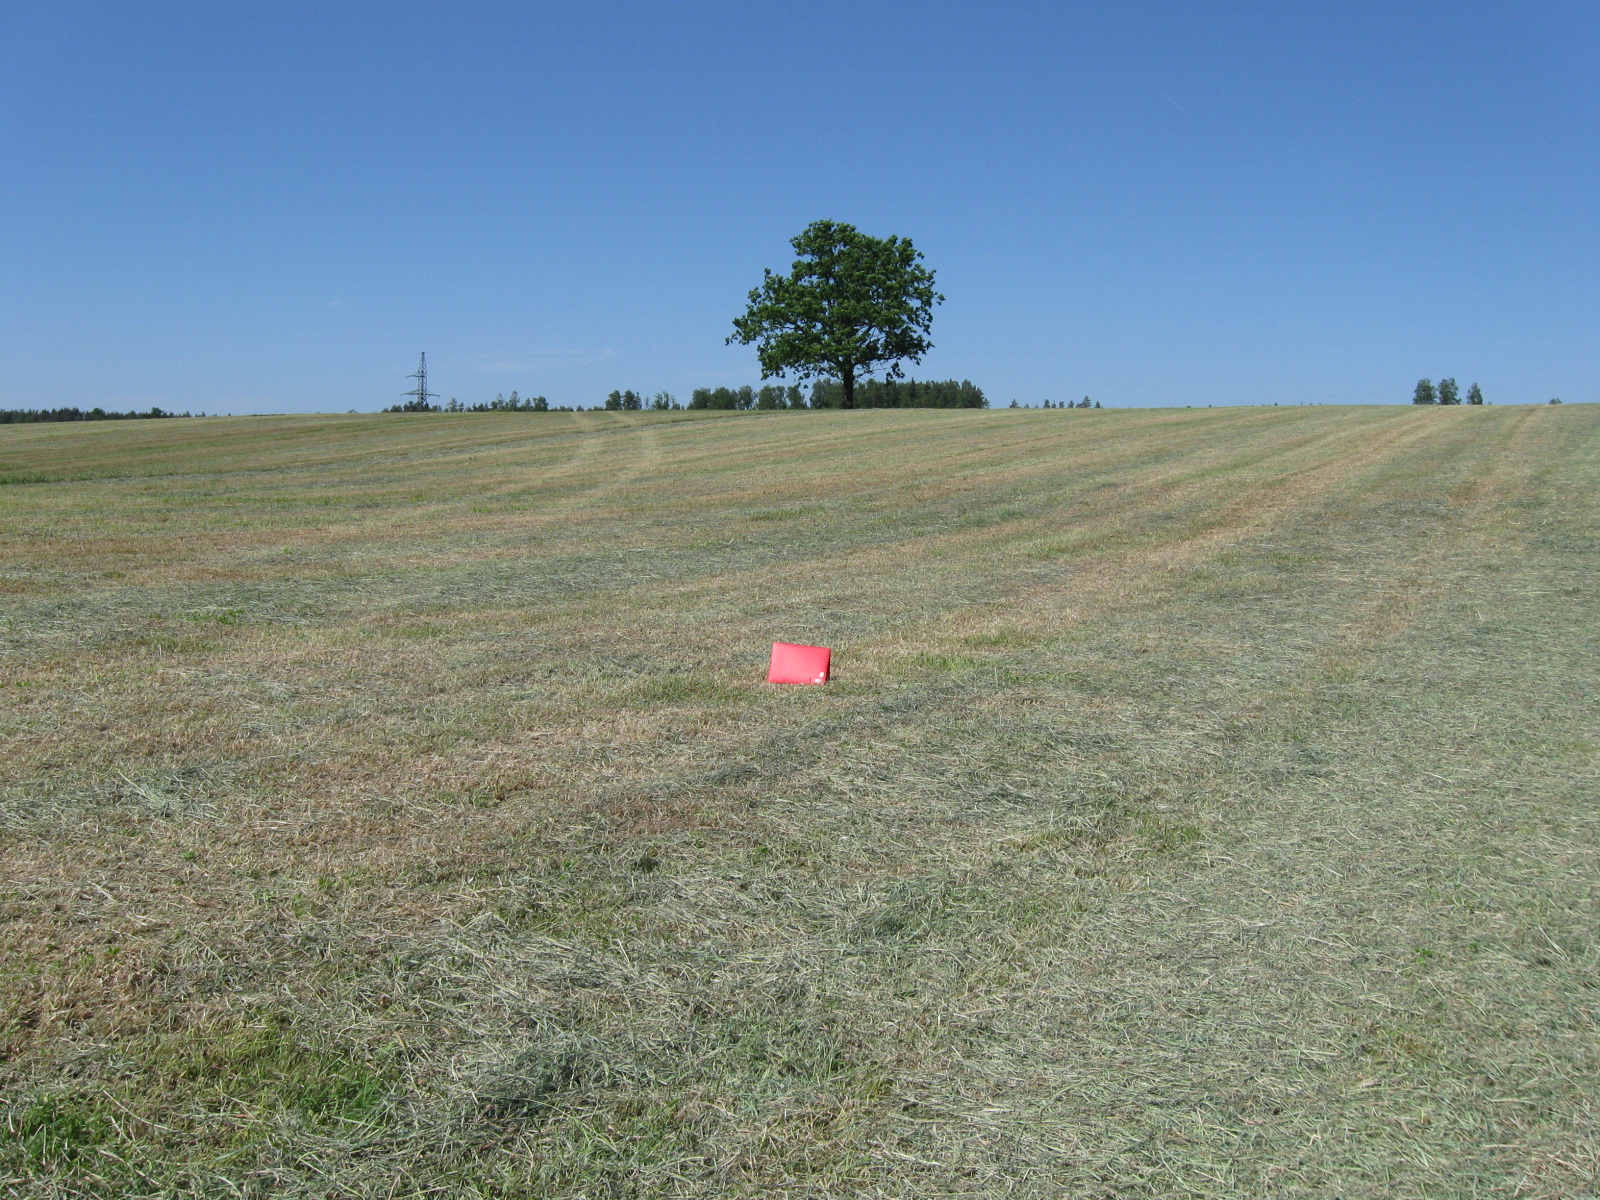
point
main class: Grassland
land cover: Grassland without tree/shrub cover
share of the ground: > 75 %
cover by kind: herbaceous plants 80 %, unconsolidated bare surface 20 %
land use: Agriculture (excluding fallow land and kitchen gardens)
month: June
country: LT
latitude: 54.8099
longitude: 24.0174
